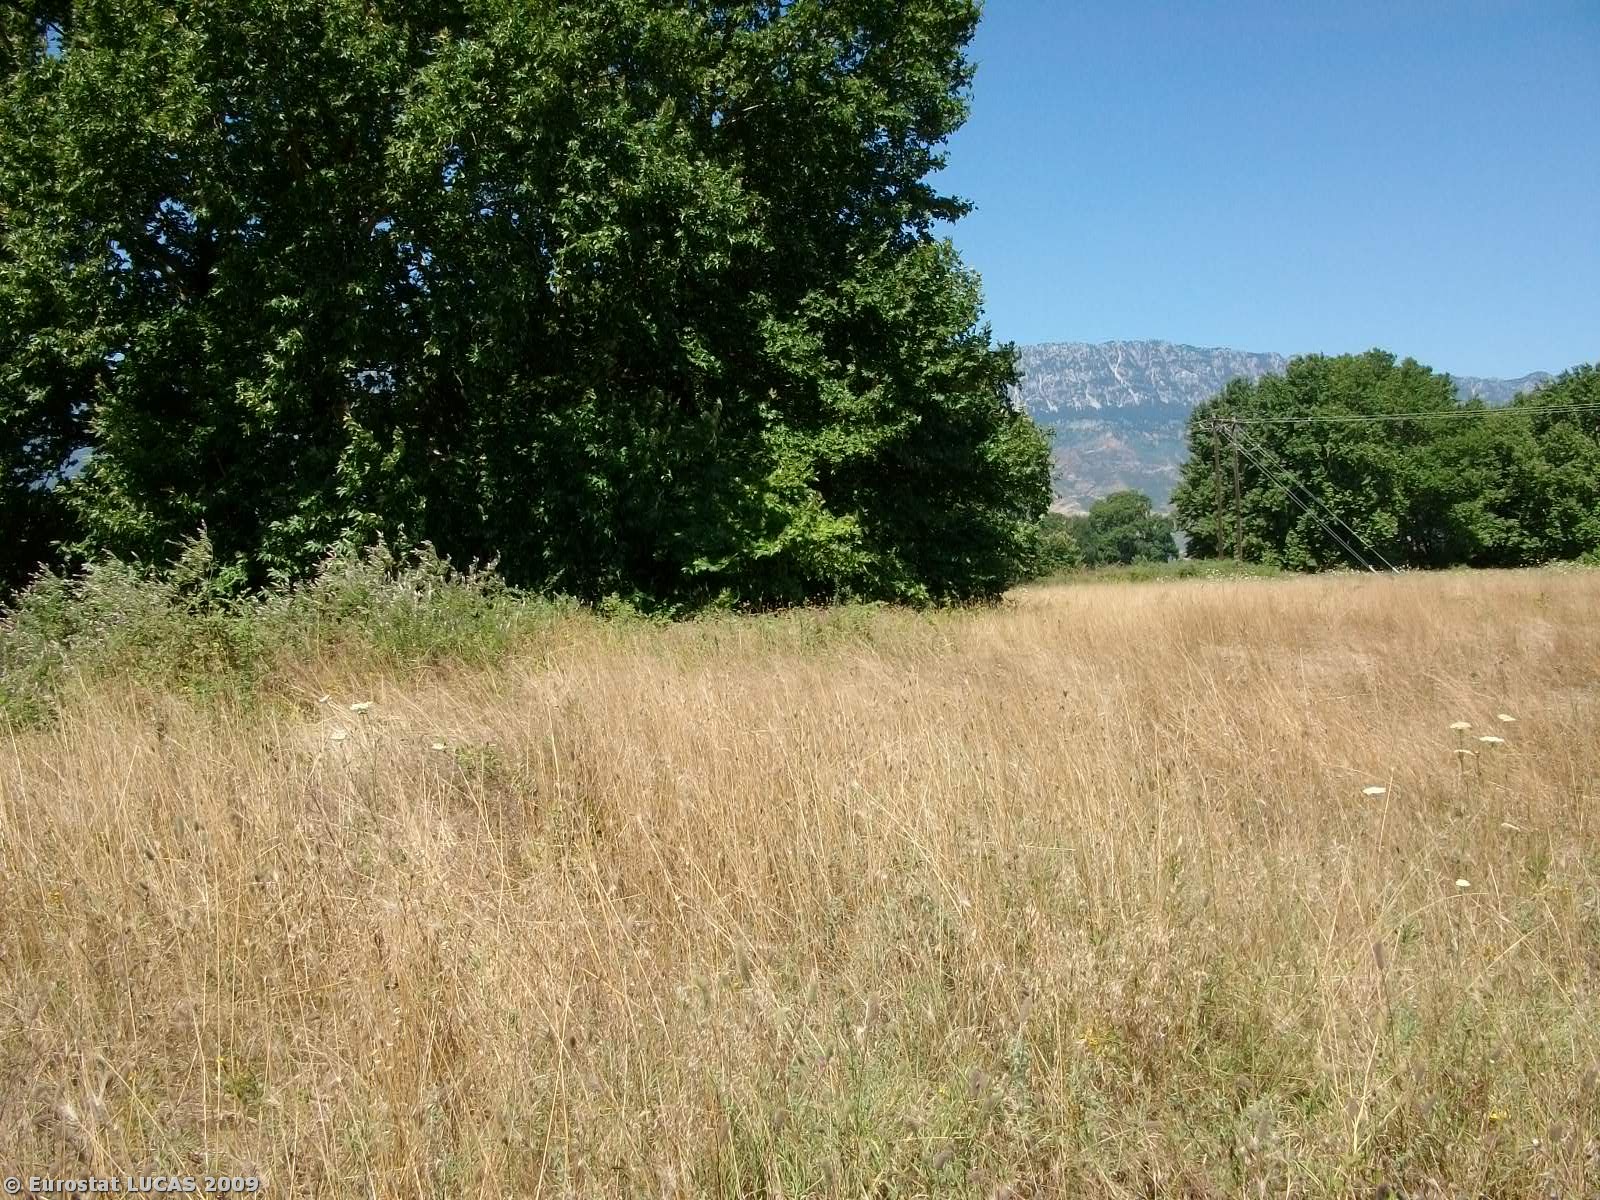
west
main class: Grassland
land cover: Grassland without tree/shrub cover
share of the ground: > 75 %
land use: Fallow land
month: July
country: GR
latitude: 39.5877
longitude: 21.6614
